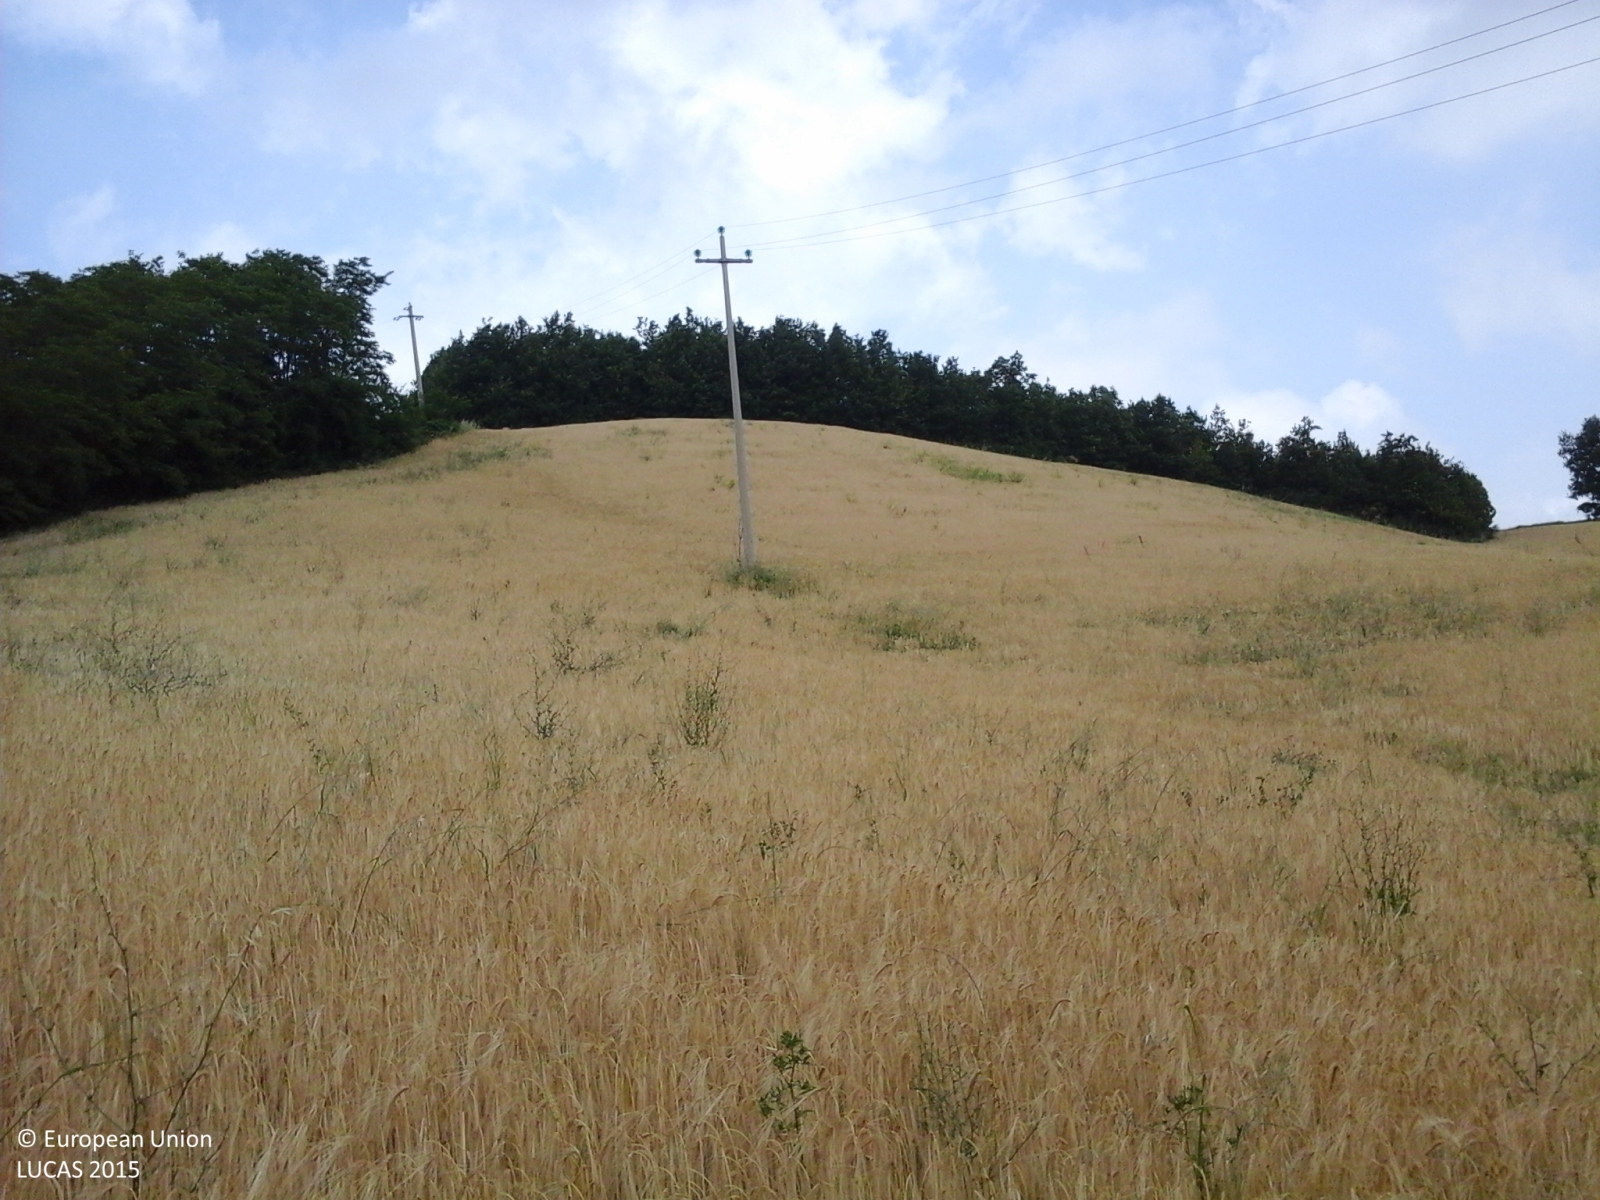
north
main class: Cropland
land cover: Barley
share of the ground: > 75 %
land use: Agriculture (excluding fallow land and kitchen gardens)
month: June
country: IT
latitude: 44.8369
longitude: 9.6592
